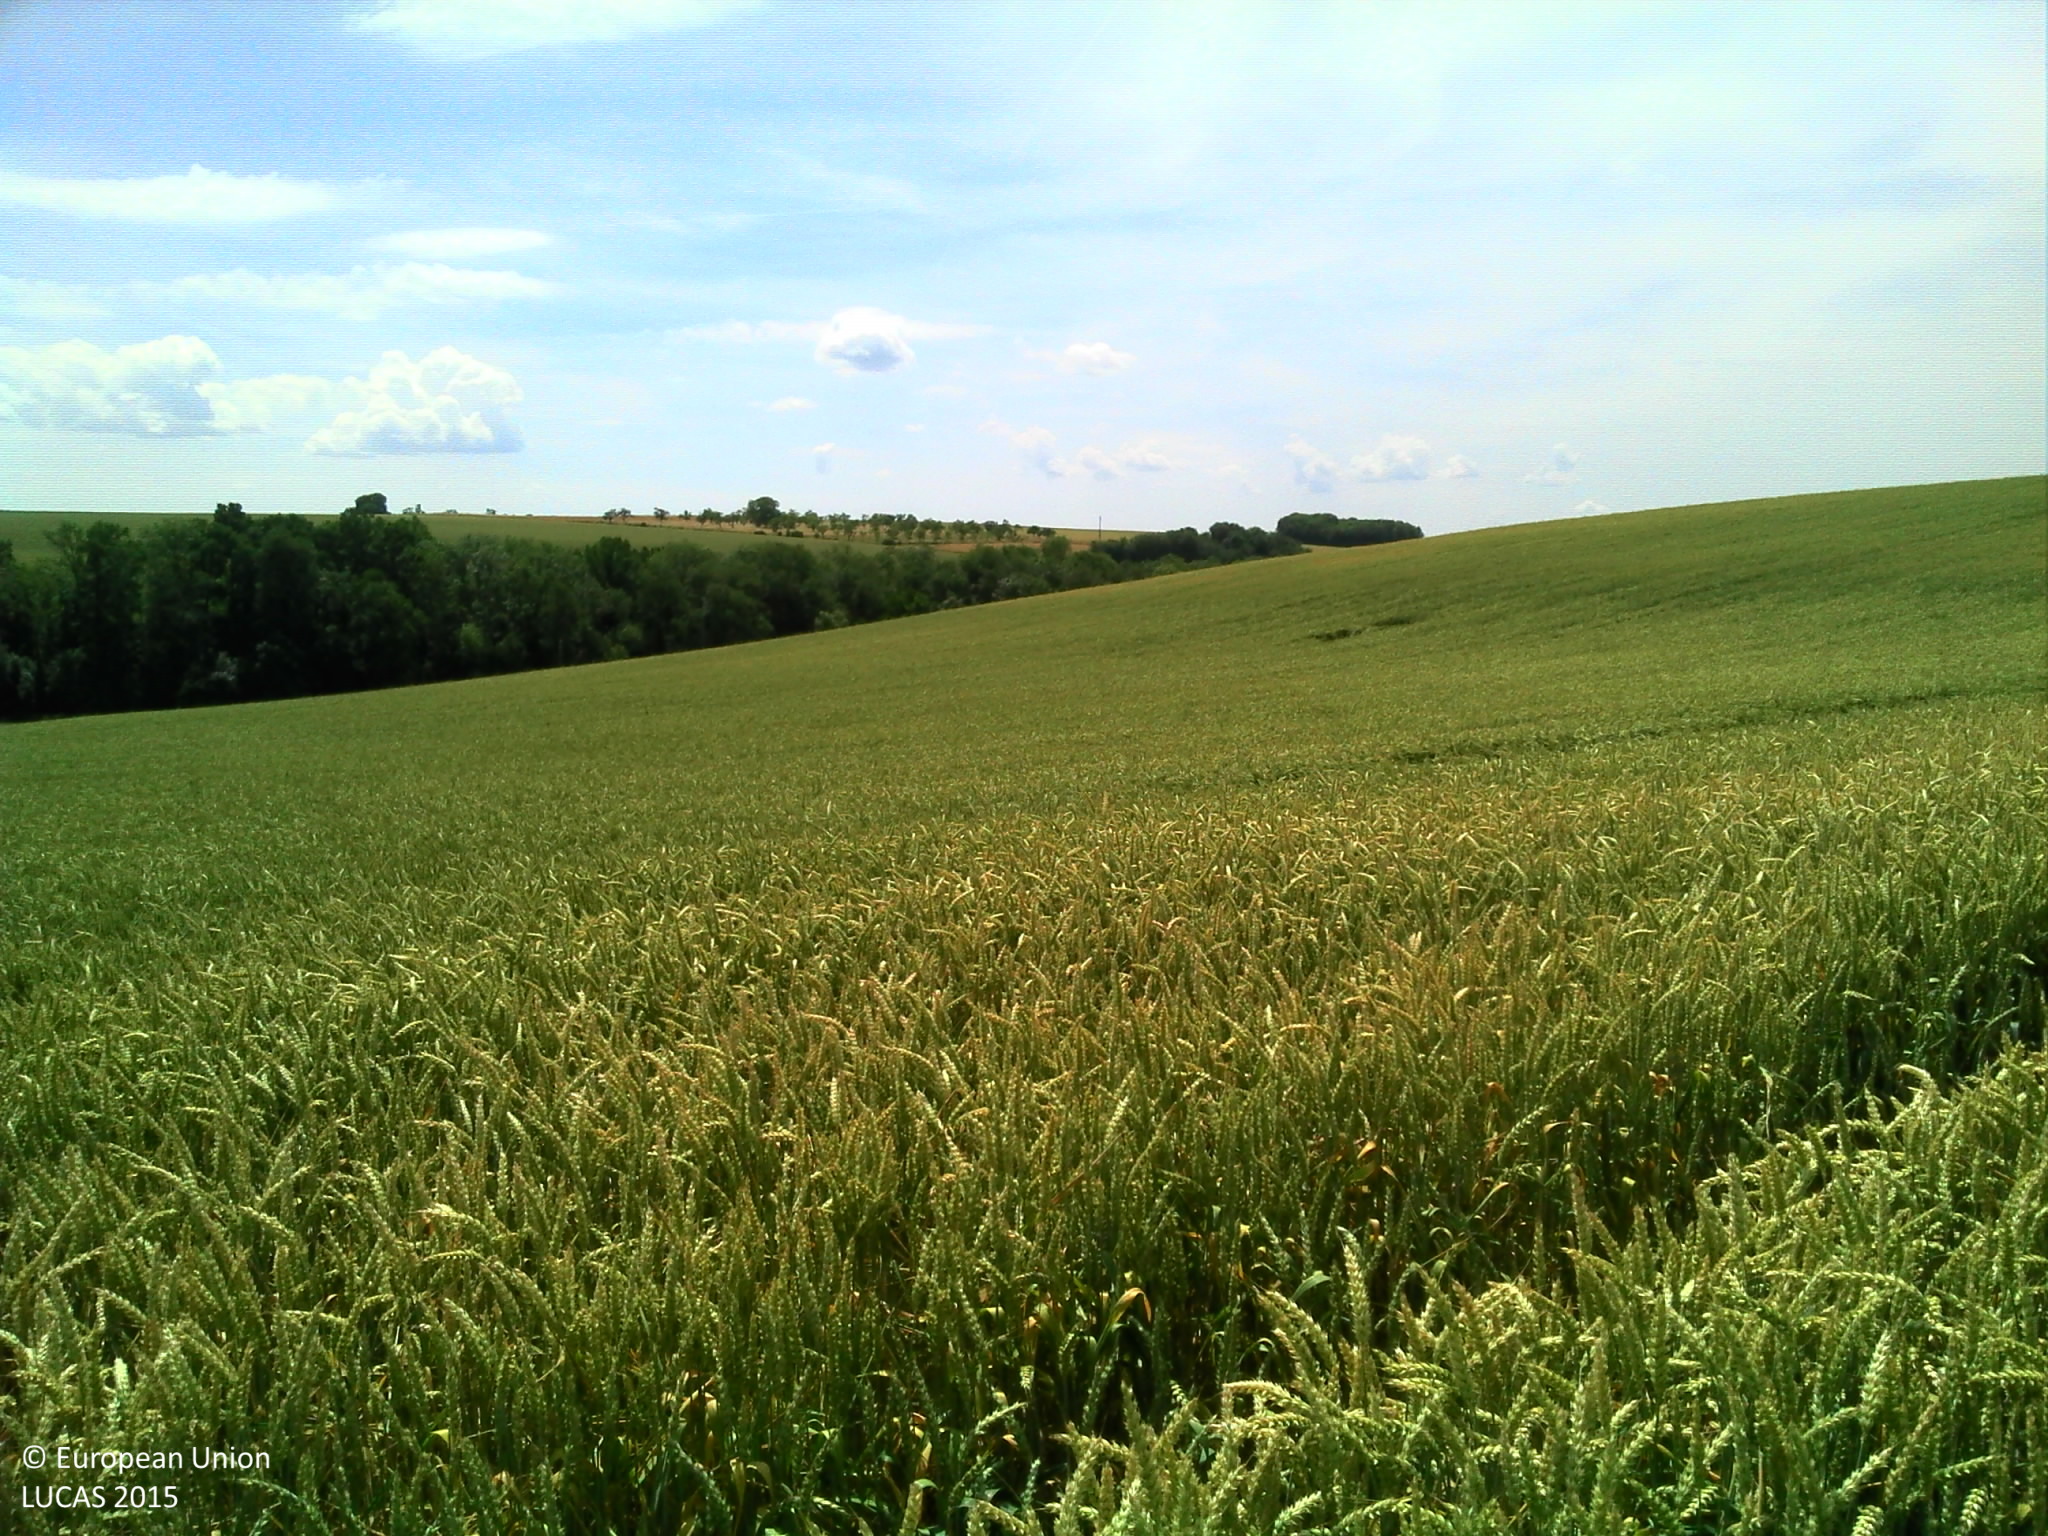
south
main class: Cropland
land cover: Common wheat
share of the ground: > 75 %
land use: Agriculture (excluding fallow land and kitchen gardens)
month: June
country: FR
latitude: 48.4104
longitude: 6.2040
